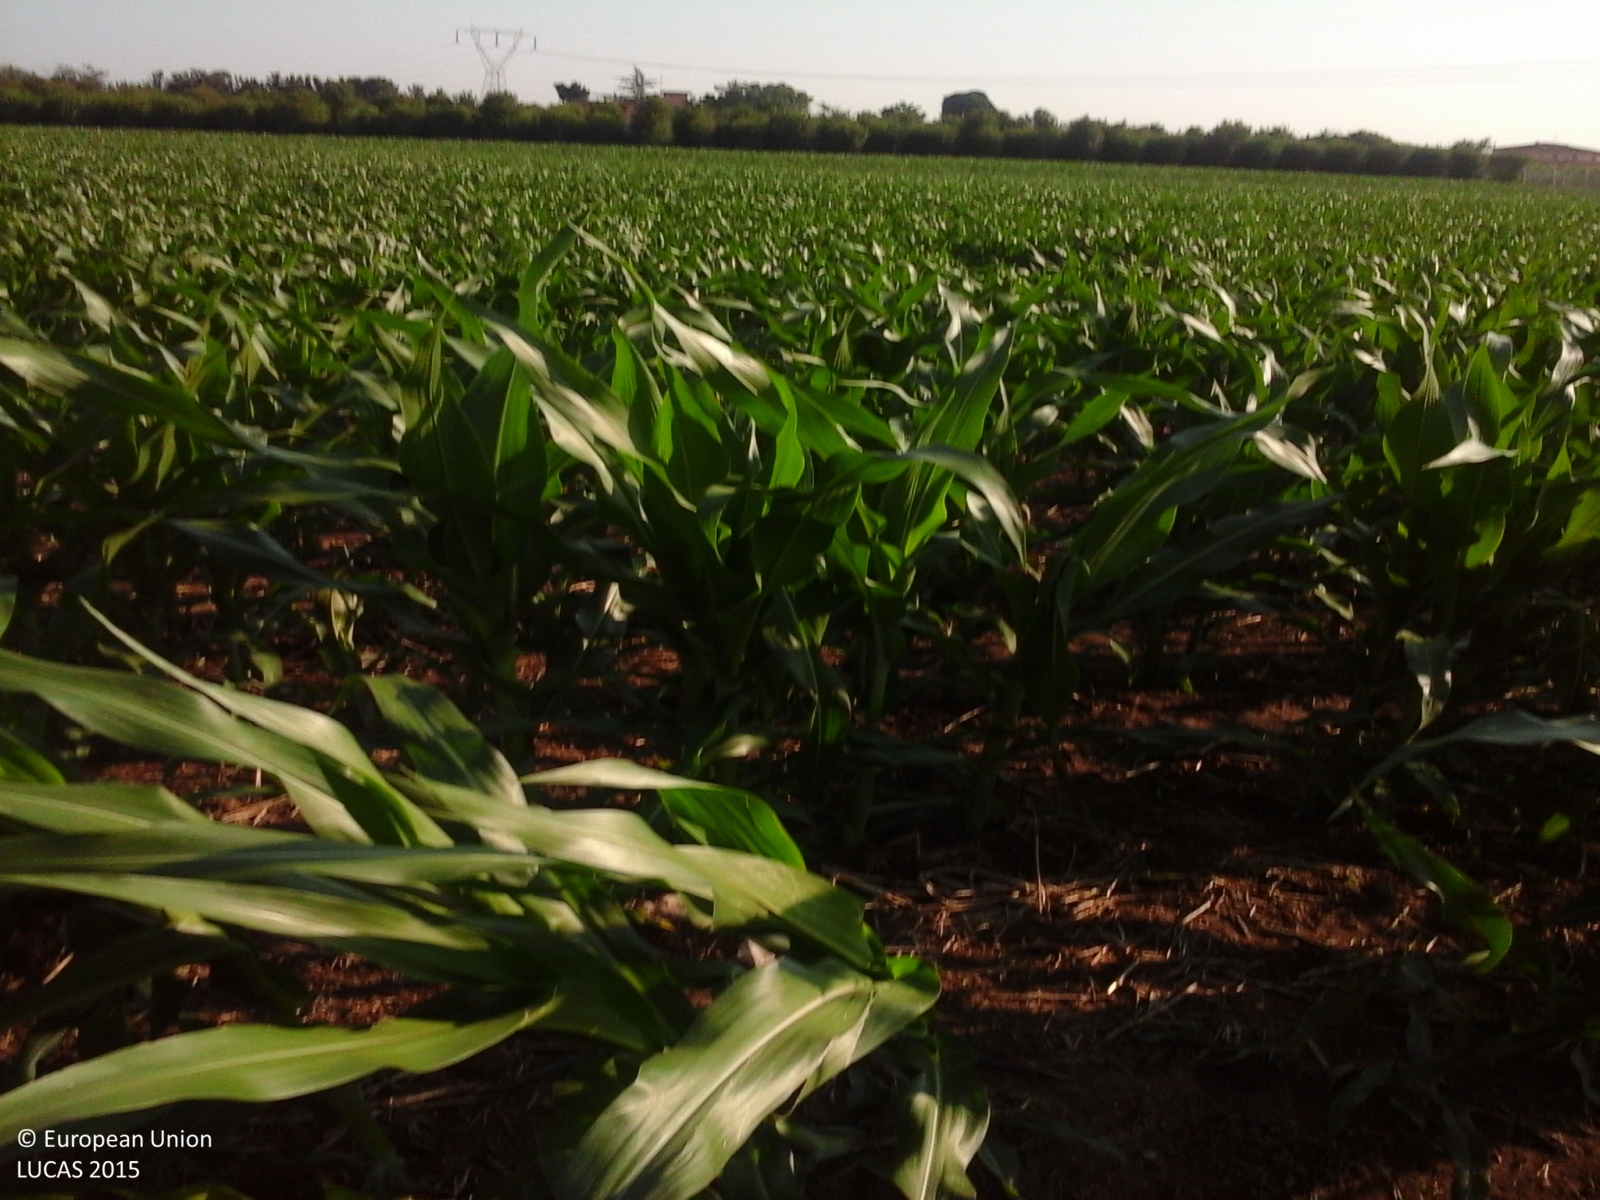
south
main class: Cropland
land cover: Maize
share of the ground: > 75 %
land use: Agriculture (excluding fallow land and kitchen gardens)
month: July
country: IT
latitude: 41.5304
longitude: 12.8054
